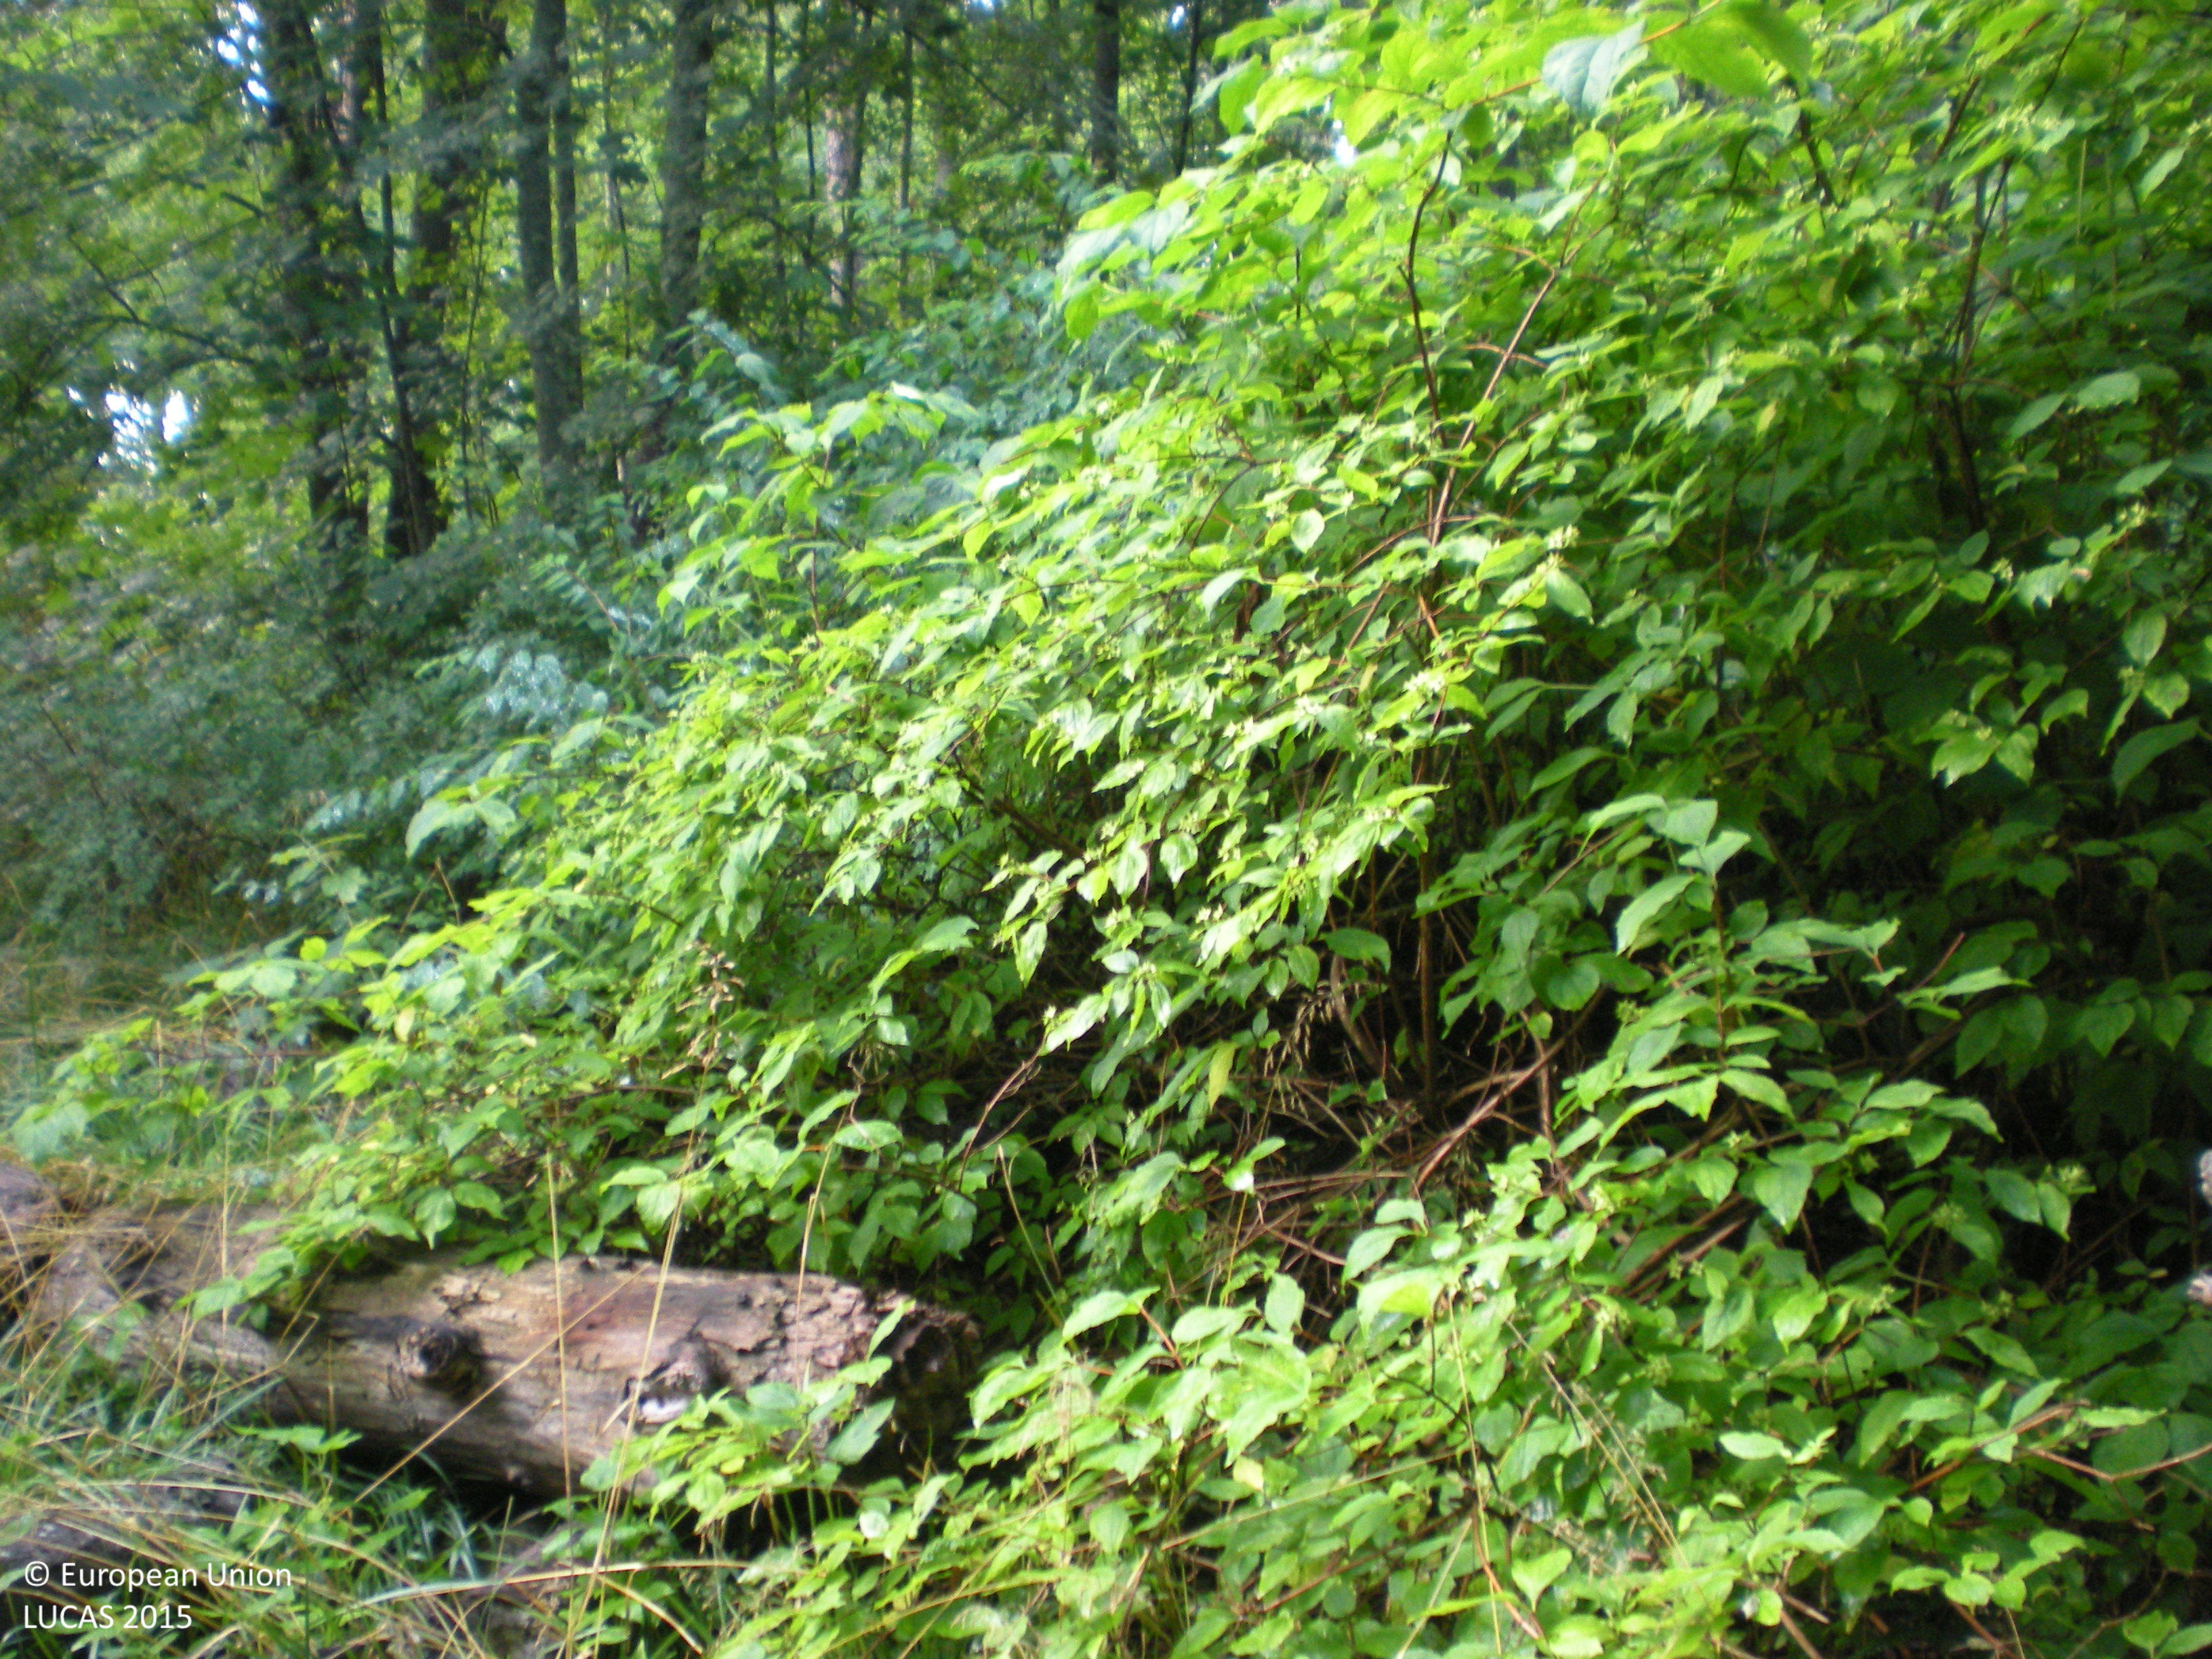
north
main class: Woodland
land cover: Broadleaved woodland
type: boreal forest
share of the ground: > 75 %
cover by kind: broadleaved forest trees 50 %, herbaceous plants 30 %, coniferous forest trees 10 %, lichens and mosses 5 %, unconsolidated bare surface 5 %
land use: Forestry
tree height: > 5 m
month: August
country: SE
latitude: 60.7009
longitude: 17.2251
